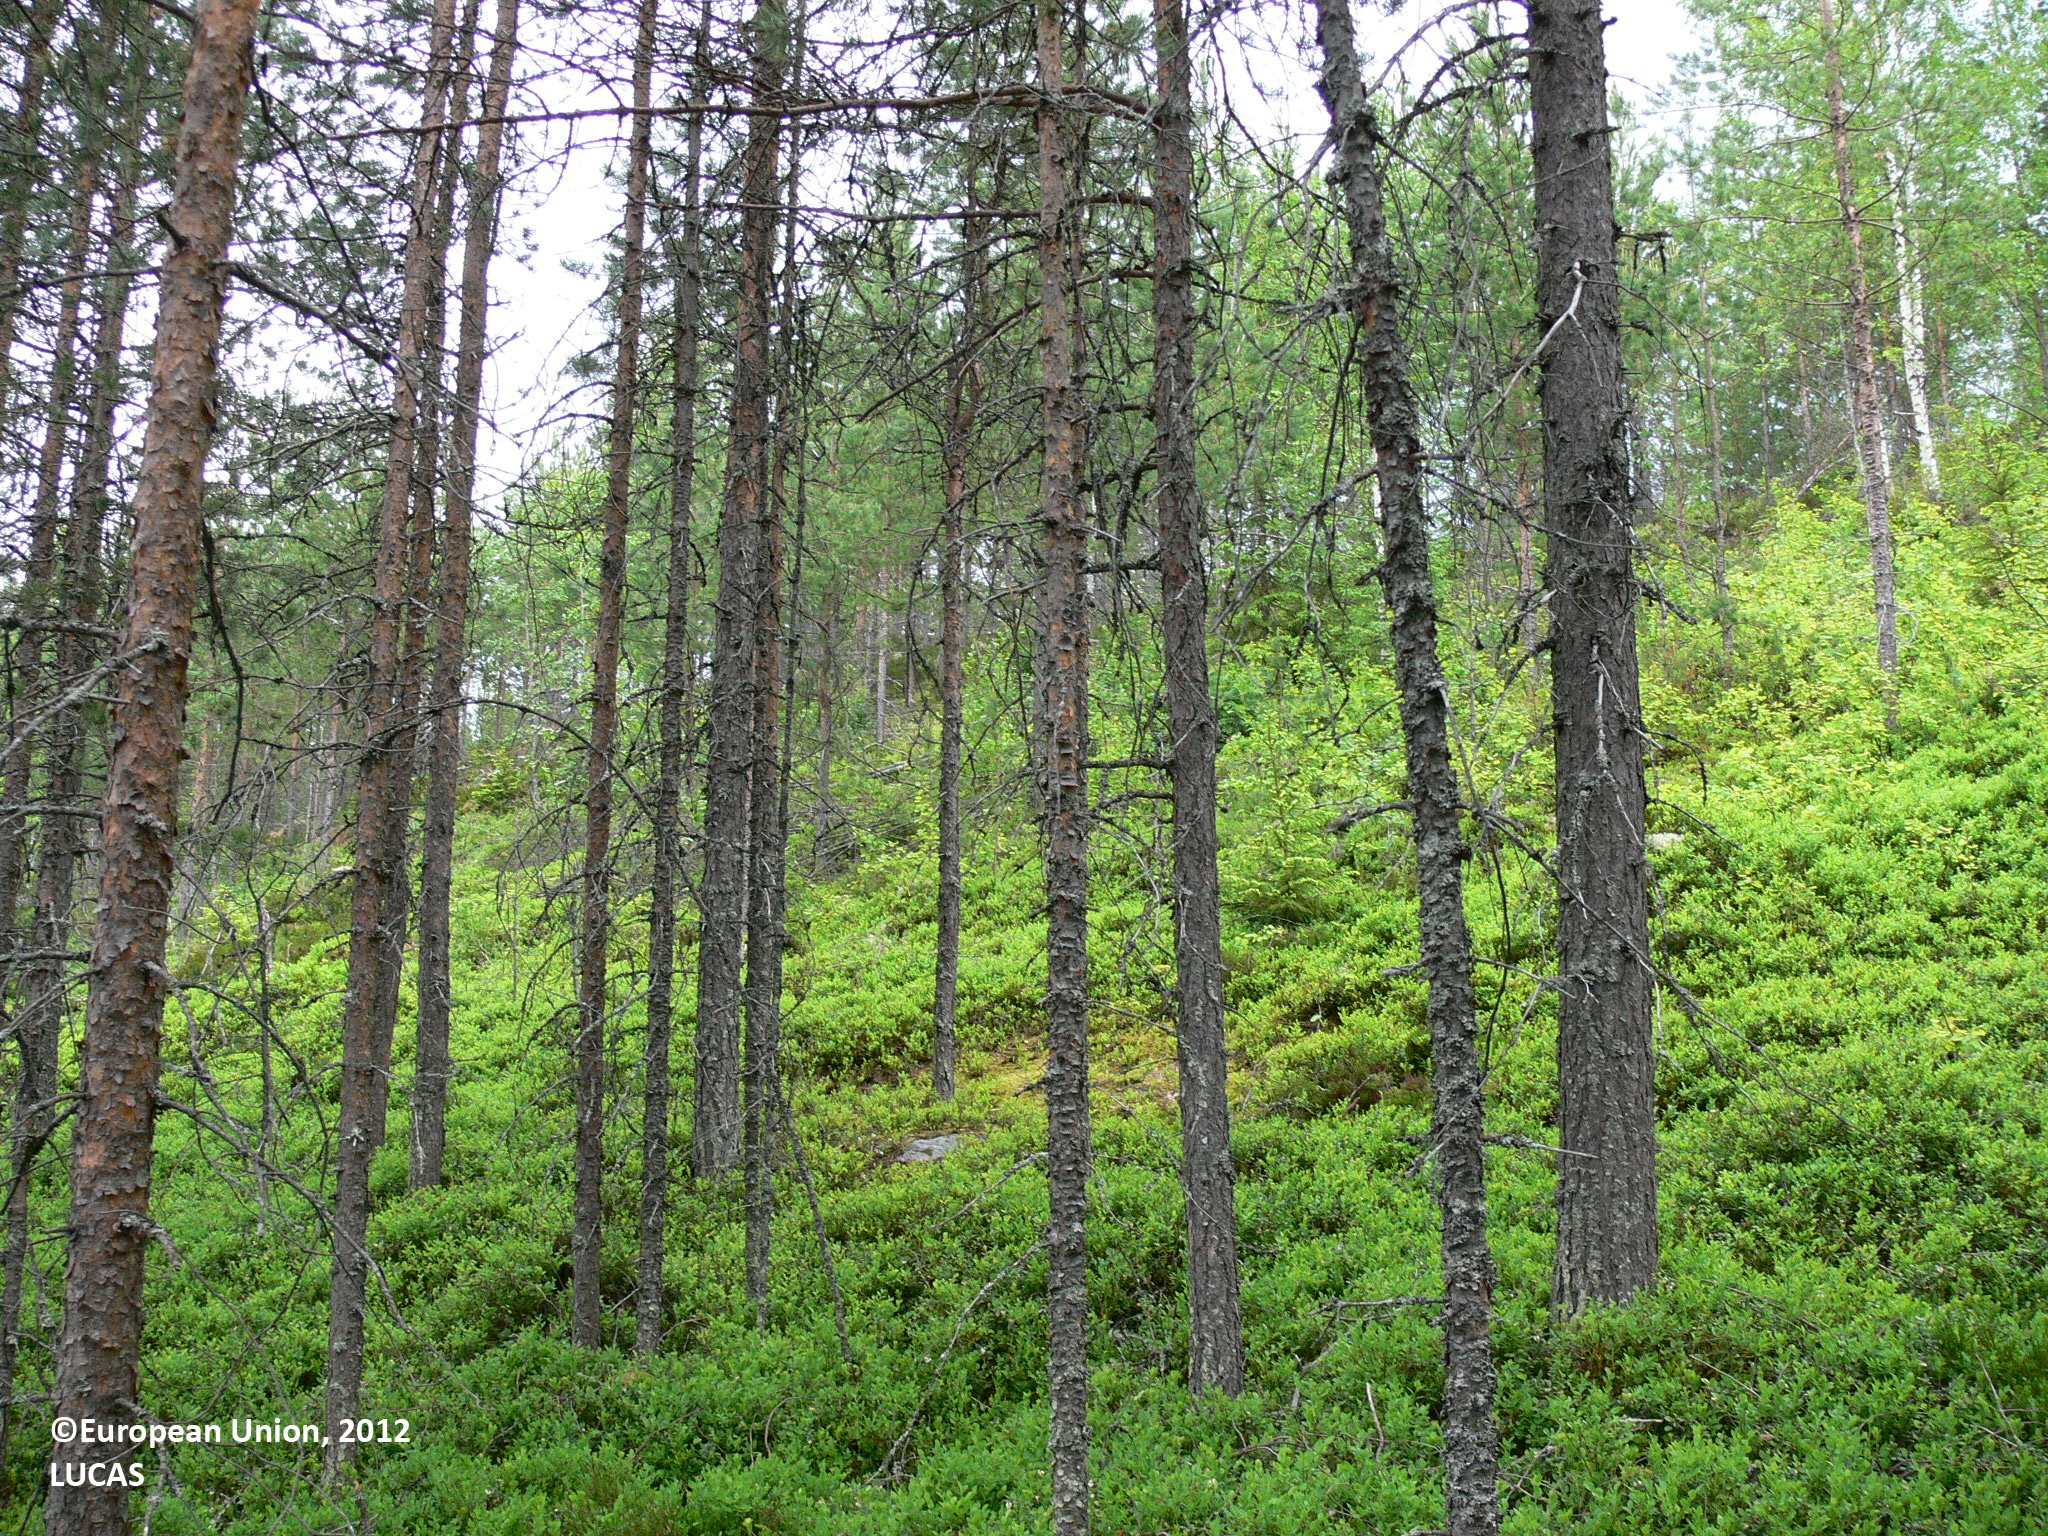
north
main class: Woodland
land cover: Pine dominated coniferous woodland
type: boreal forest
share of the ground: > 75 %
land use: Forestry
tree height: > 5 m
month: June
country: FI
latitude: 62.9290
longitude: 29.8872
